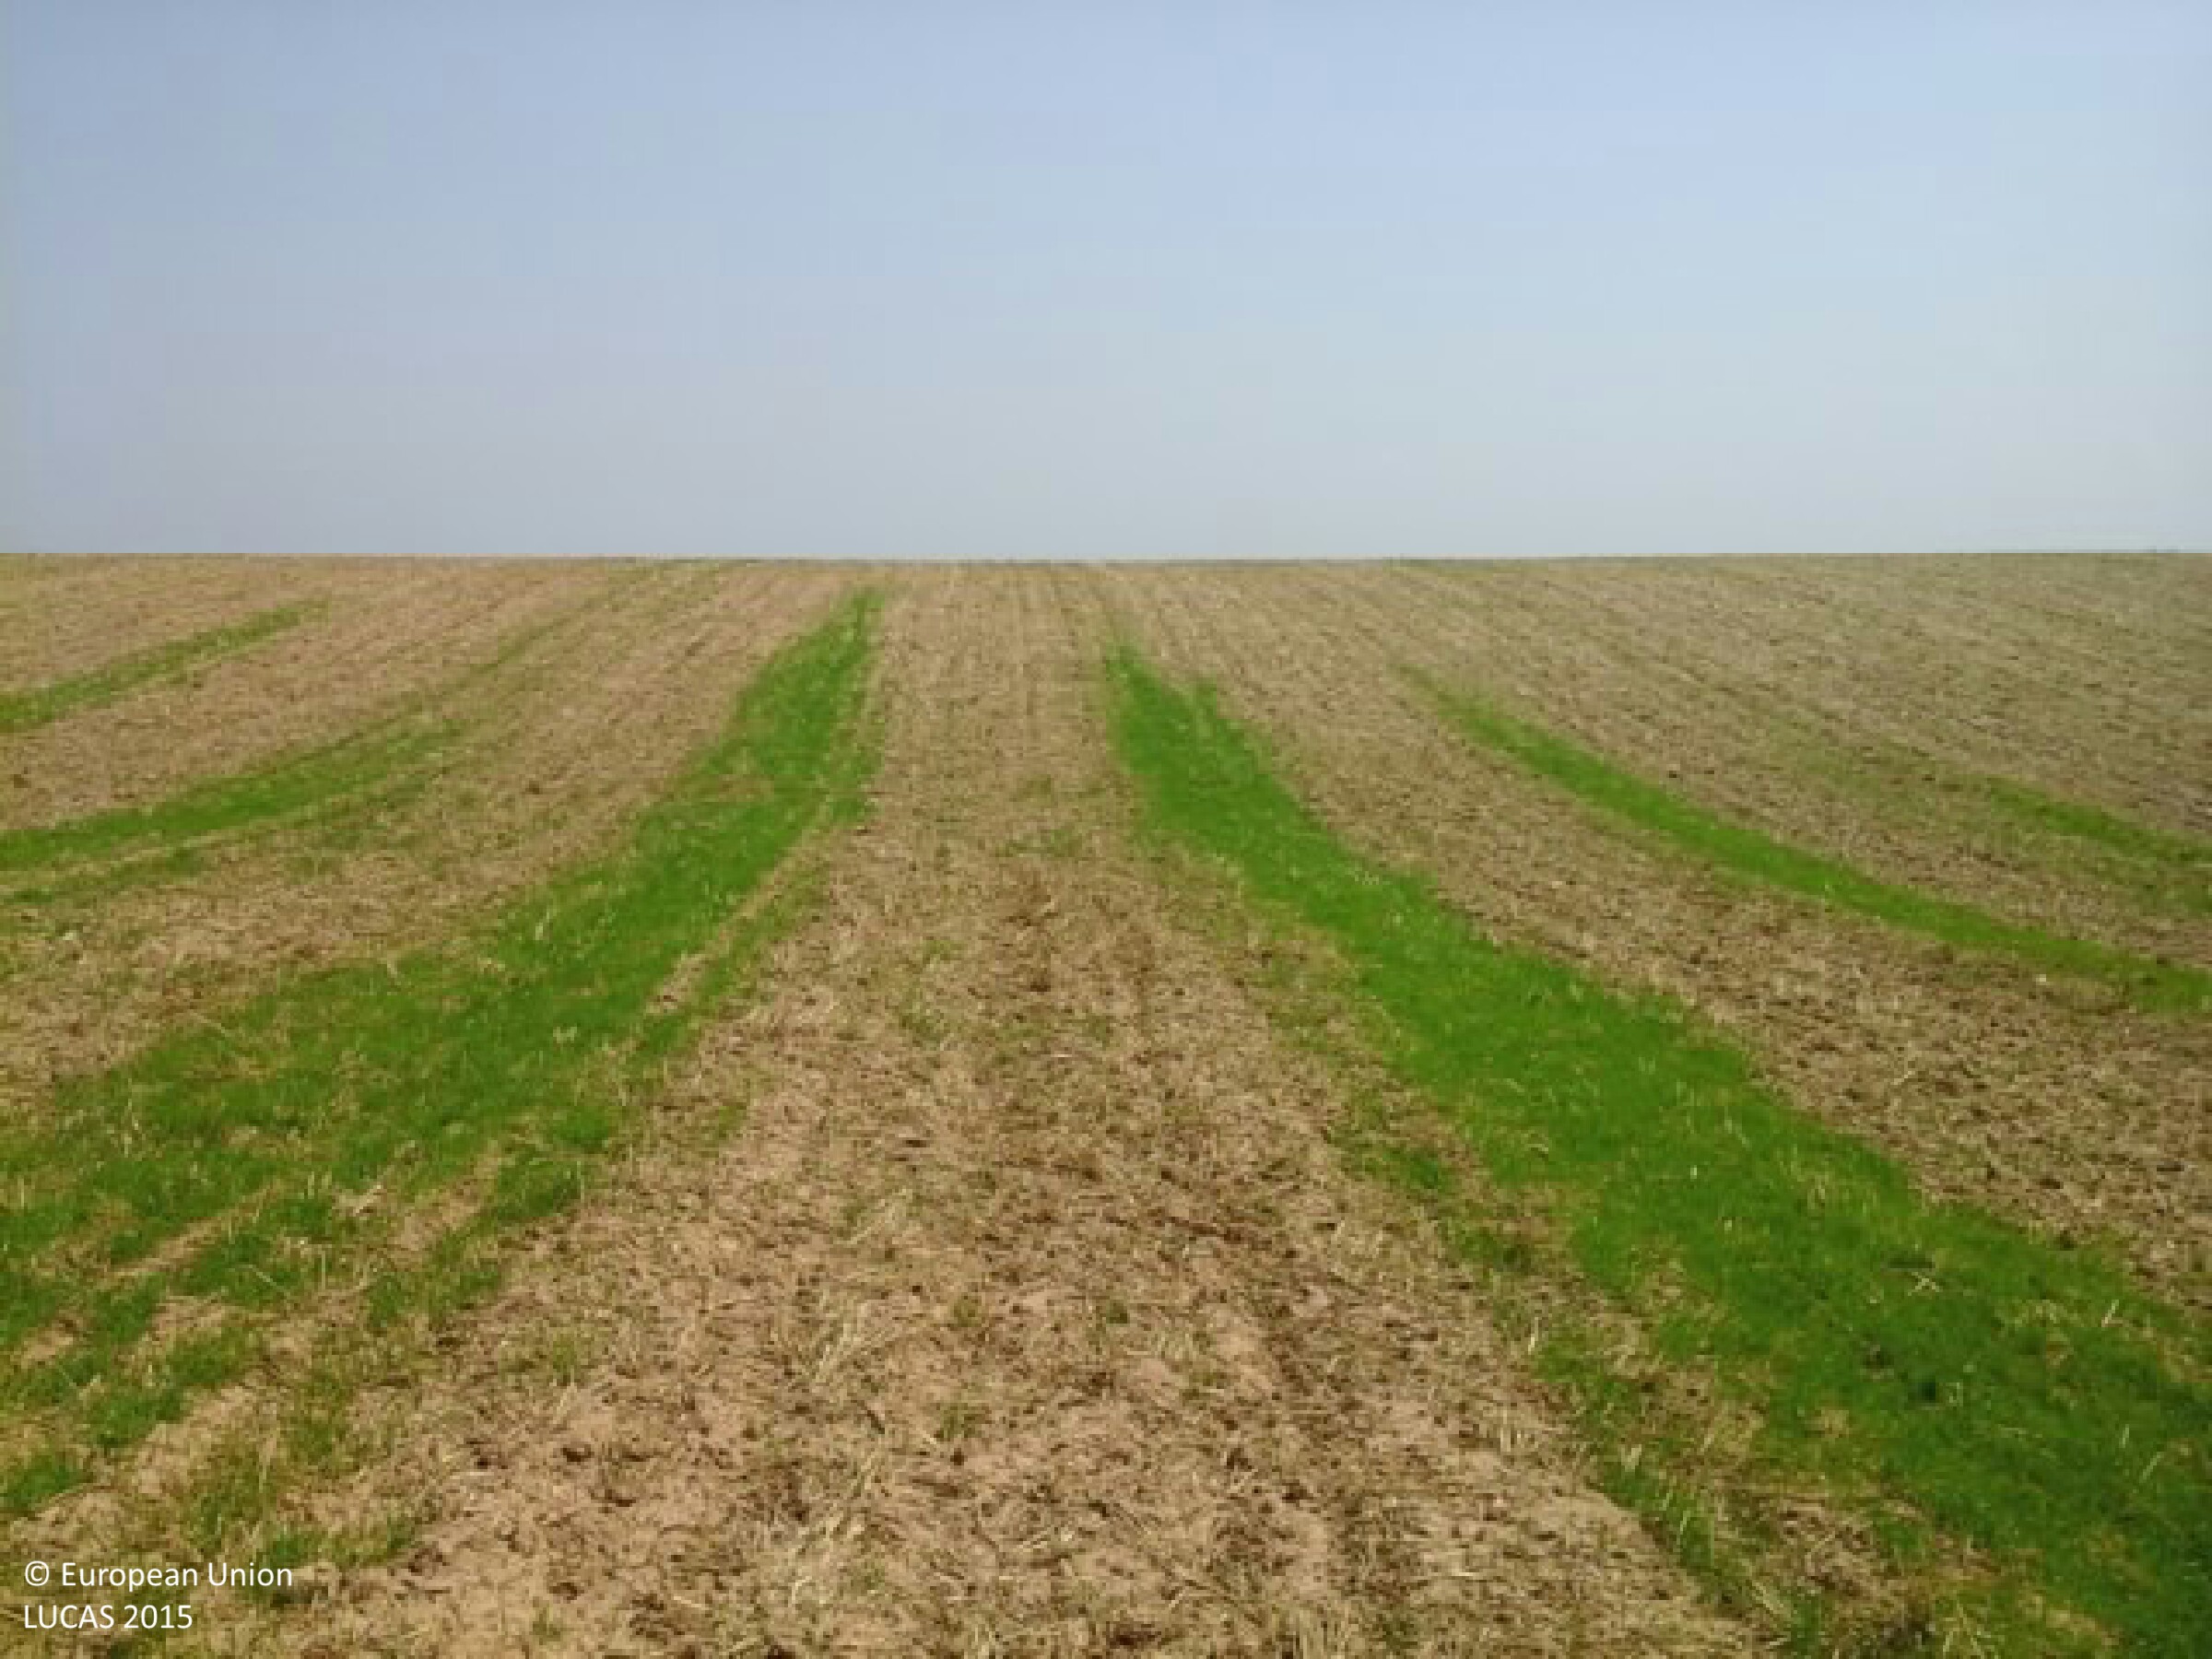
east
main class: Cropland
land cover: Common wheat
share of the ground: > 75 %
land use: Agriculture (excluding fallow land and kitchen gardens)
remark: Harvested field
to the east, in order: Common wheat
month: August
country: HU
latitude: 46.5289
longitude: 17.3967
